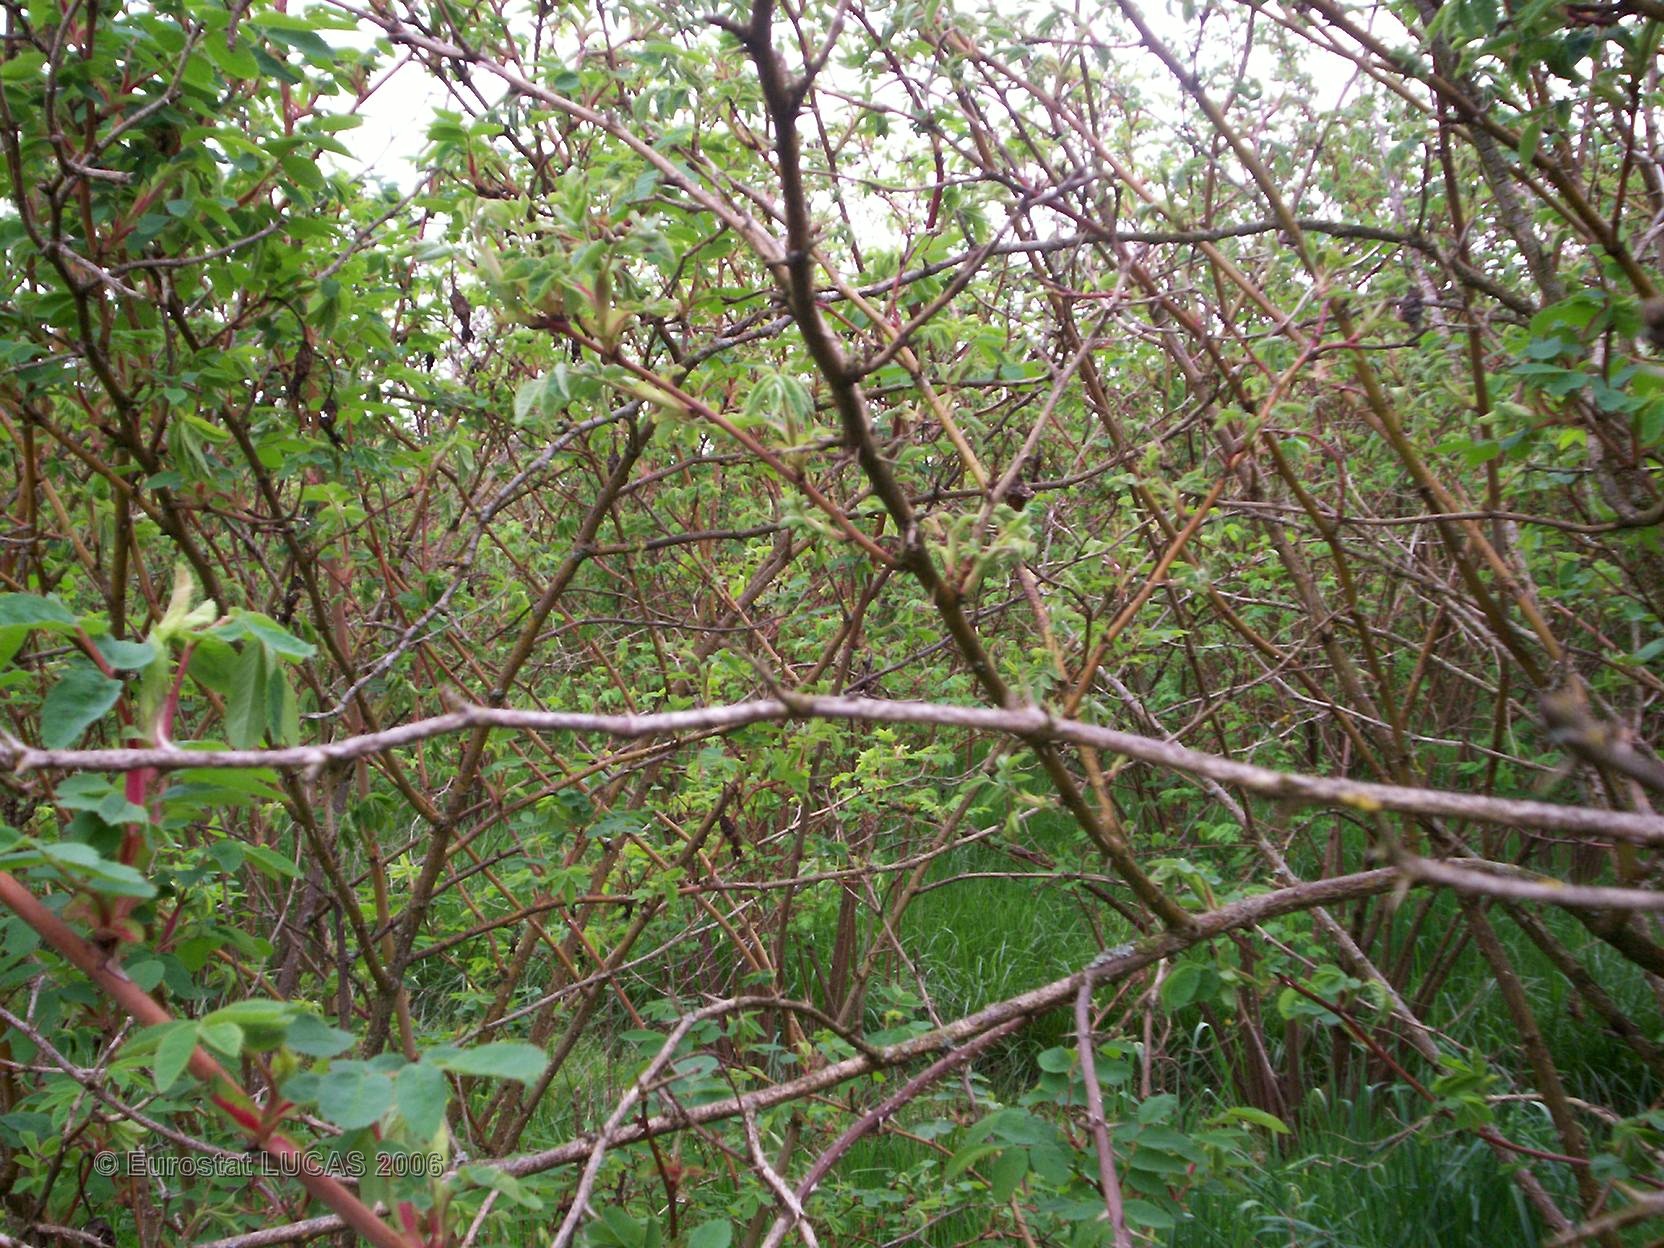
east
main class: Cropland
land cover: Other fruit trees and berries
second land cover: Grassland with sparse tree/shrub cover
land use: Agriculture (excluding fallow land and kitchen gardens)
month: April
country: FR
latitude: 48.0467
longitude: 2.8690
